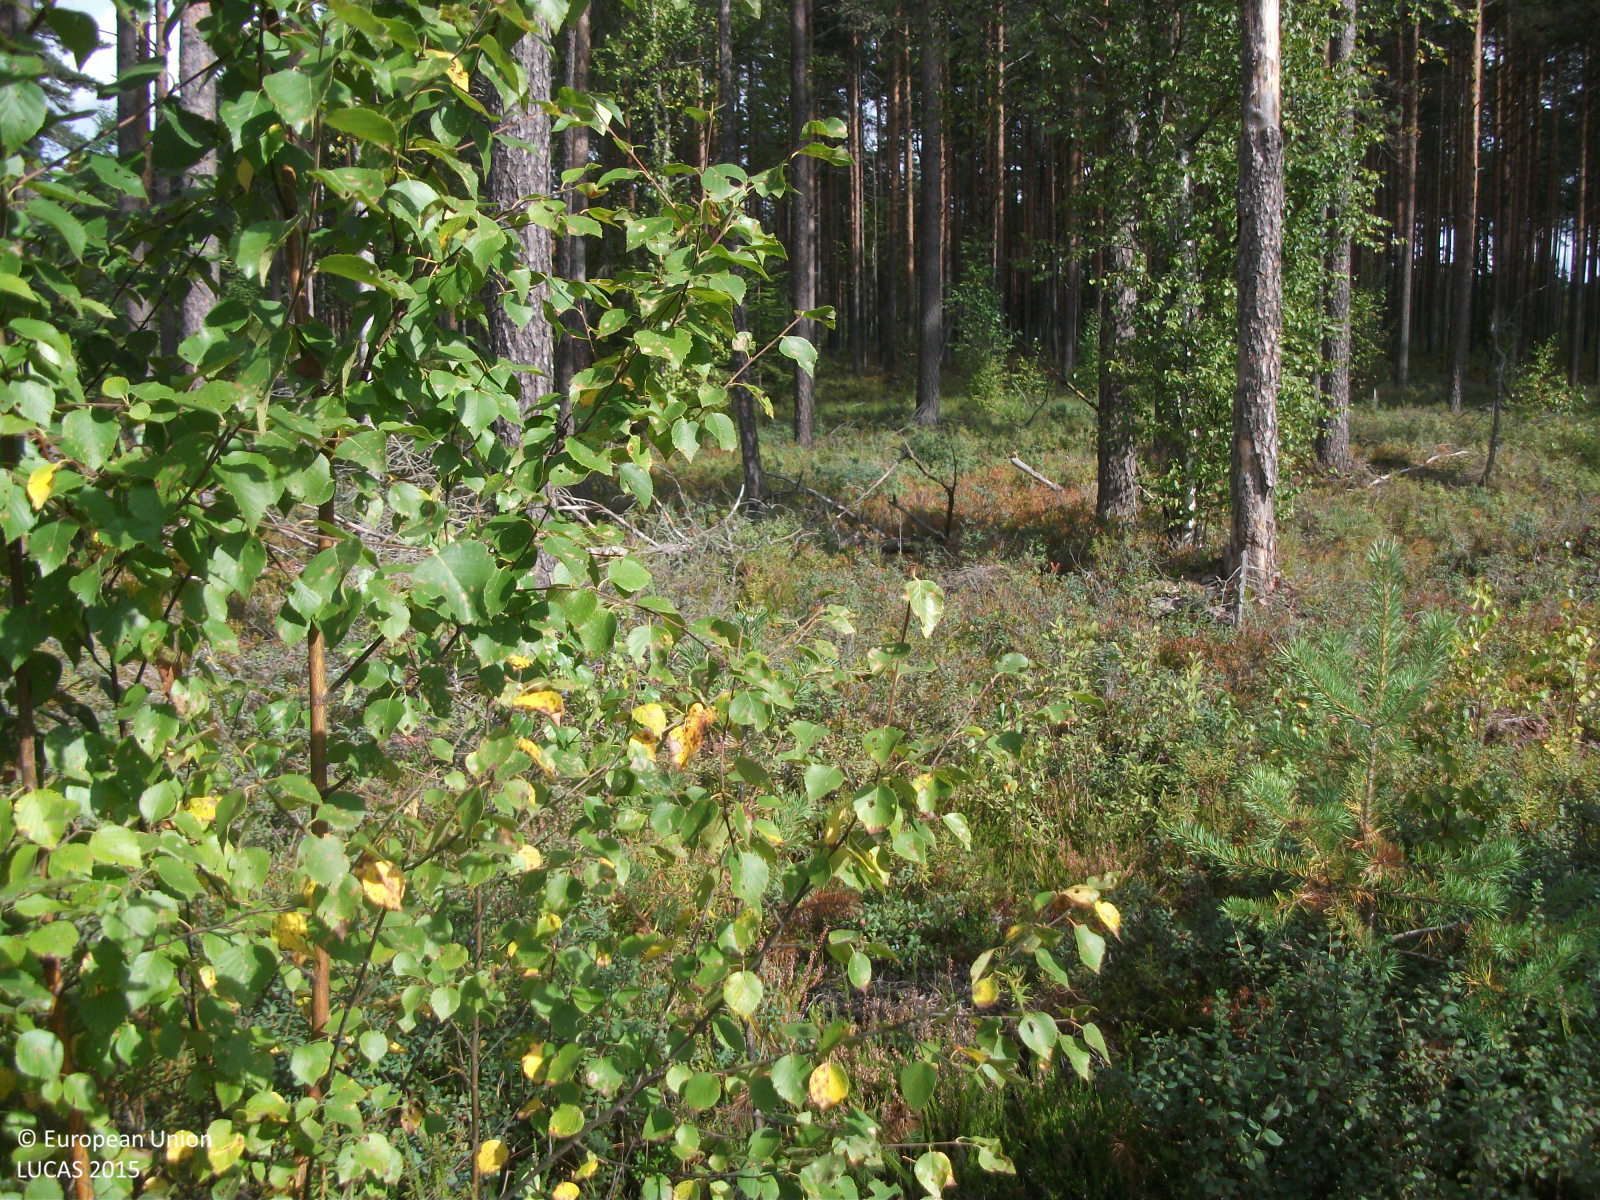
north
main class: Woodland
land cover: Other mixed woodland
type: hemiboreal forest and nemoral coniferous forest and mixed broadleaved-coniferous forest
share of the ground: 50 - 75 %
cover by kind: broadleaved forest trees 45 %, coniferous forest trees 25 %, shrubs 15 %, herbaceous plants 10 %, lichens and mosses 5 %
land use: Forestry
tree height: < 5 m
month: September
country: LV
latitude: 56.5774
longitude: 26.2394
